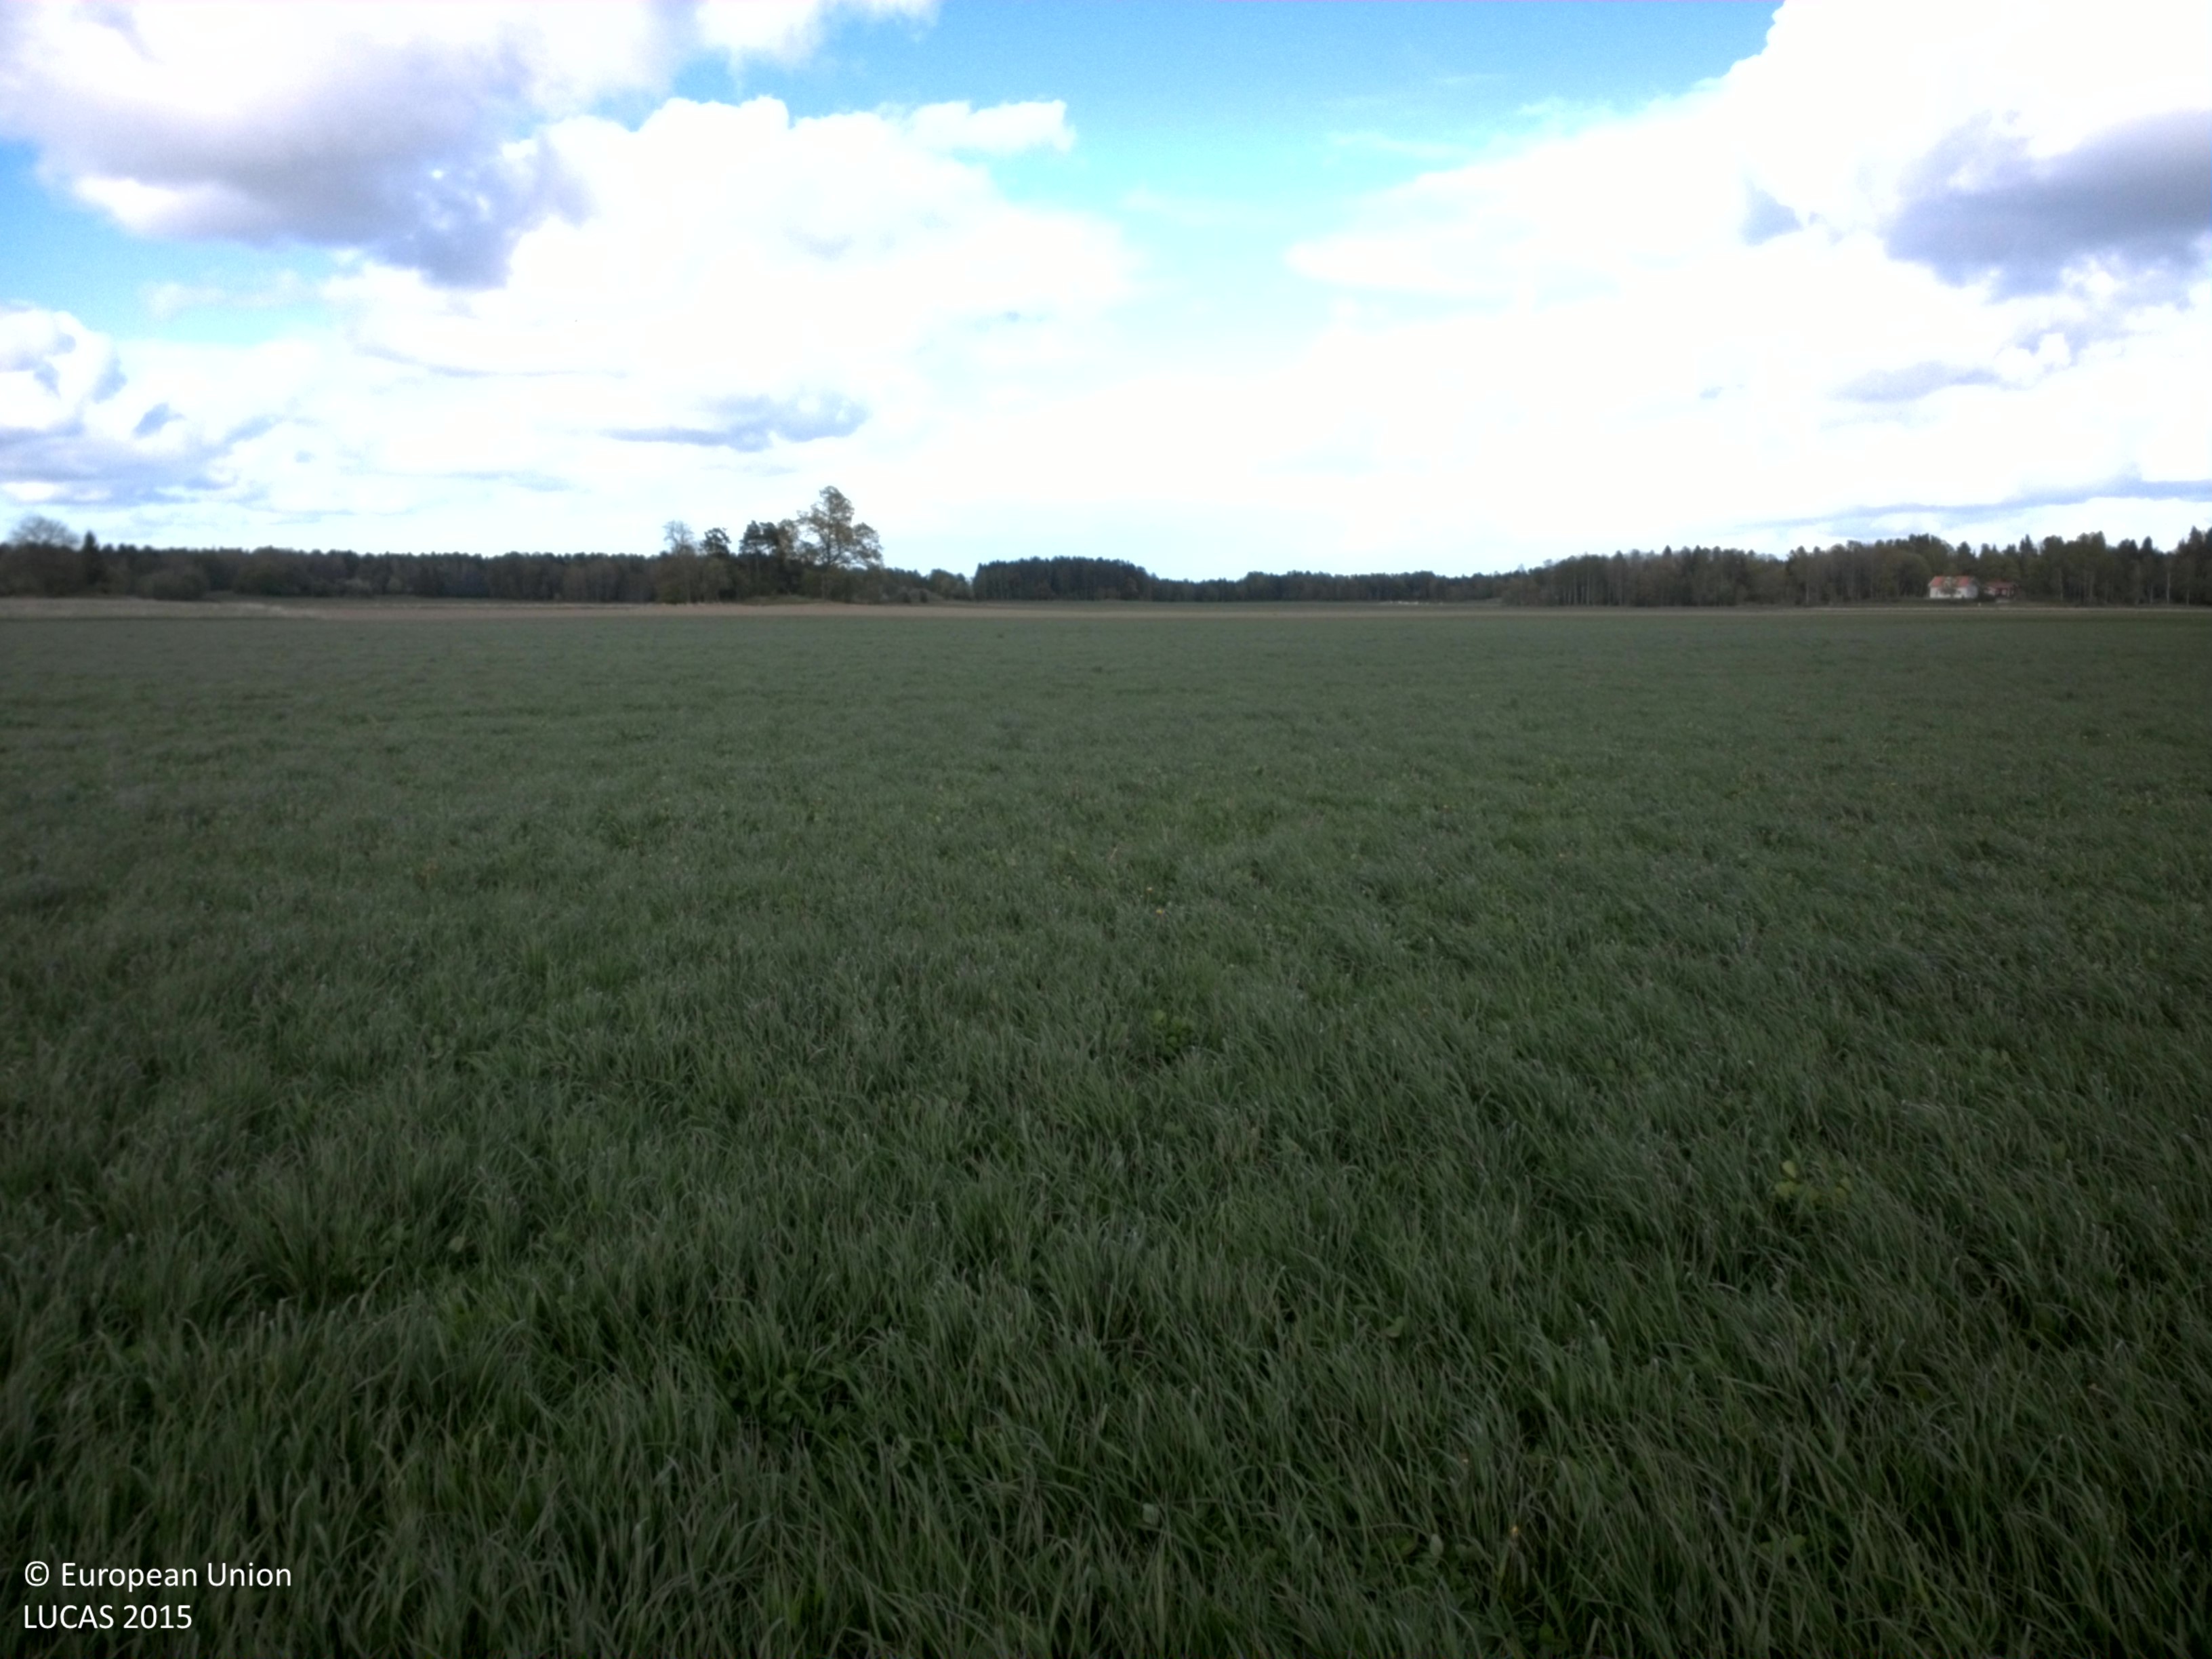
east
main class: Cropland
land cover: Temporary grasslands
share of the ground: > 75 %
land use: Agriculture (excluding fallow land and kitchen gardens)
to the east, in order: Temporary grasslands; Oats
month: May
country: SE
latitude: 58.4516
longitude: 12.3087
